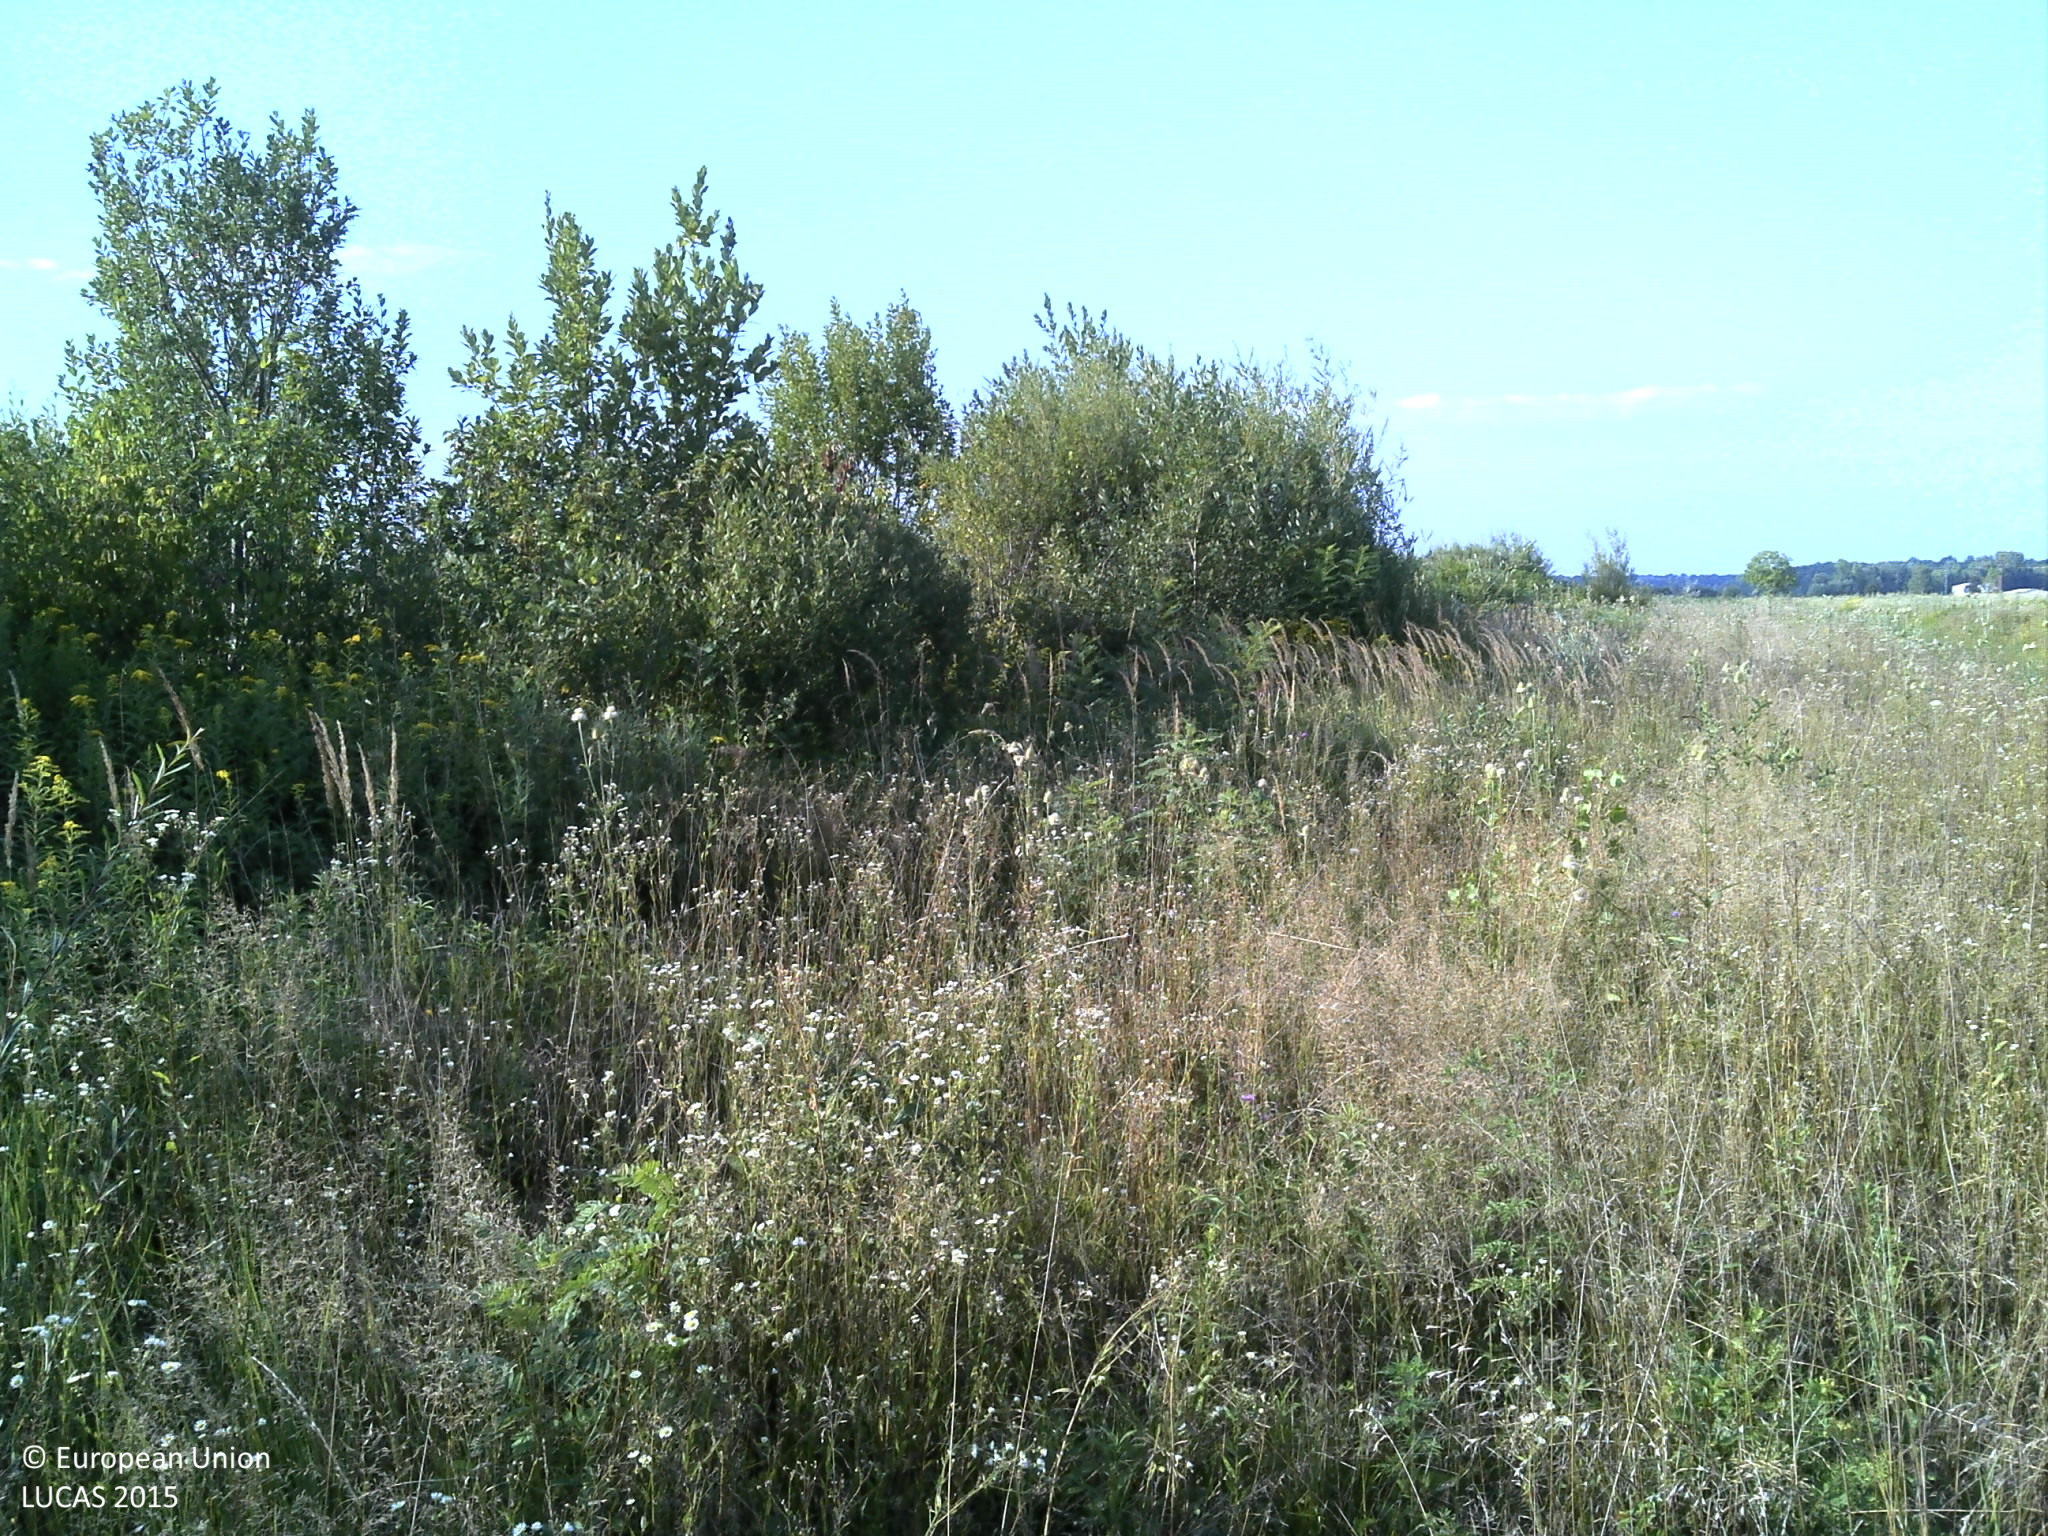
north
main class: Grassland
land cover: Grassland without tree/shrub cover
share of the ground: > 75 %
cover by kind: herbaceous plants 100 %
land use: Semi-natural and natural areas not in use
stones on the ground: < 10 %
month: August
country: HR
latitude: 45.4678
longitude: 16.4827
